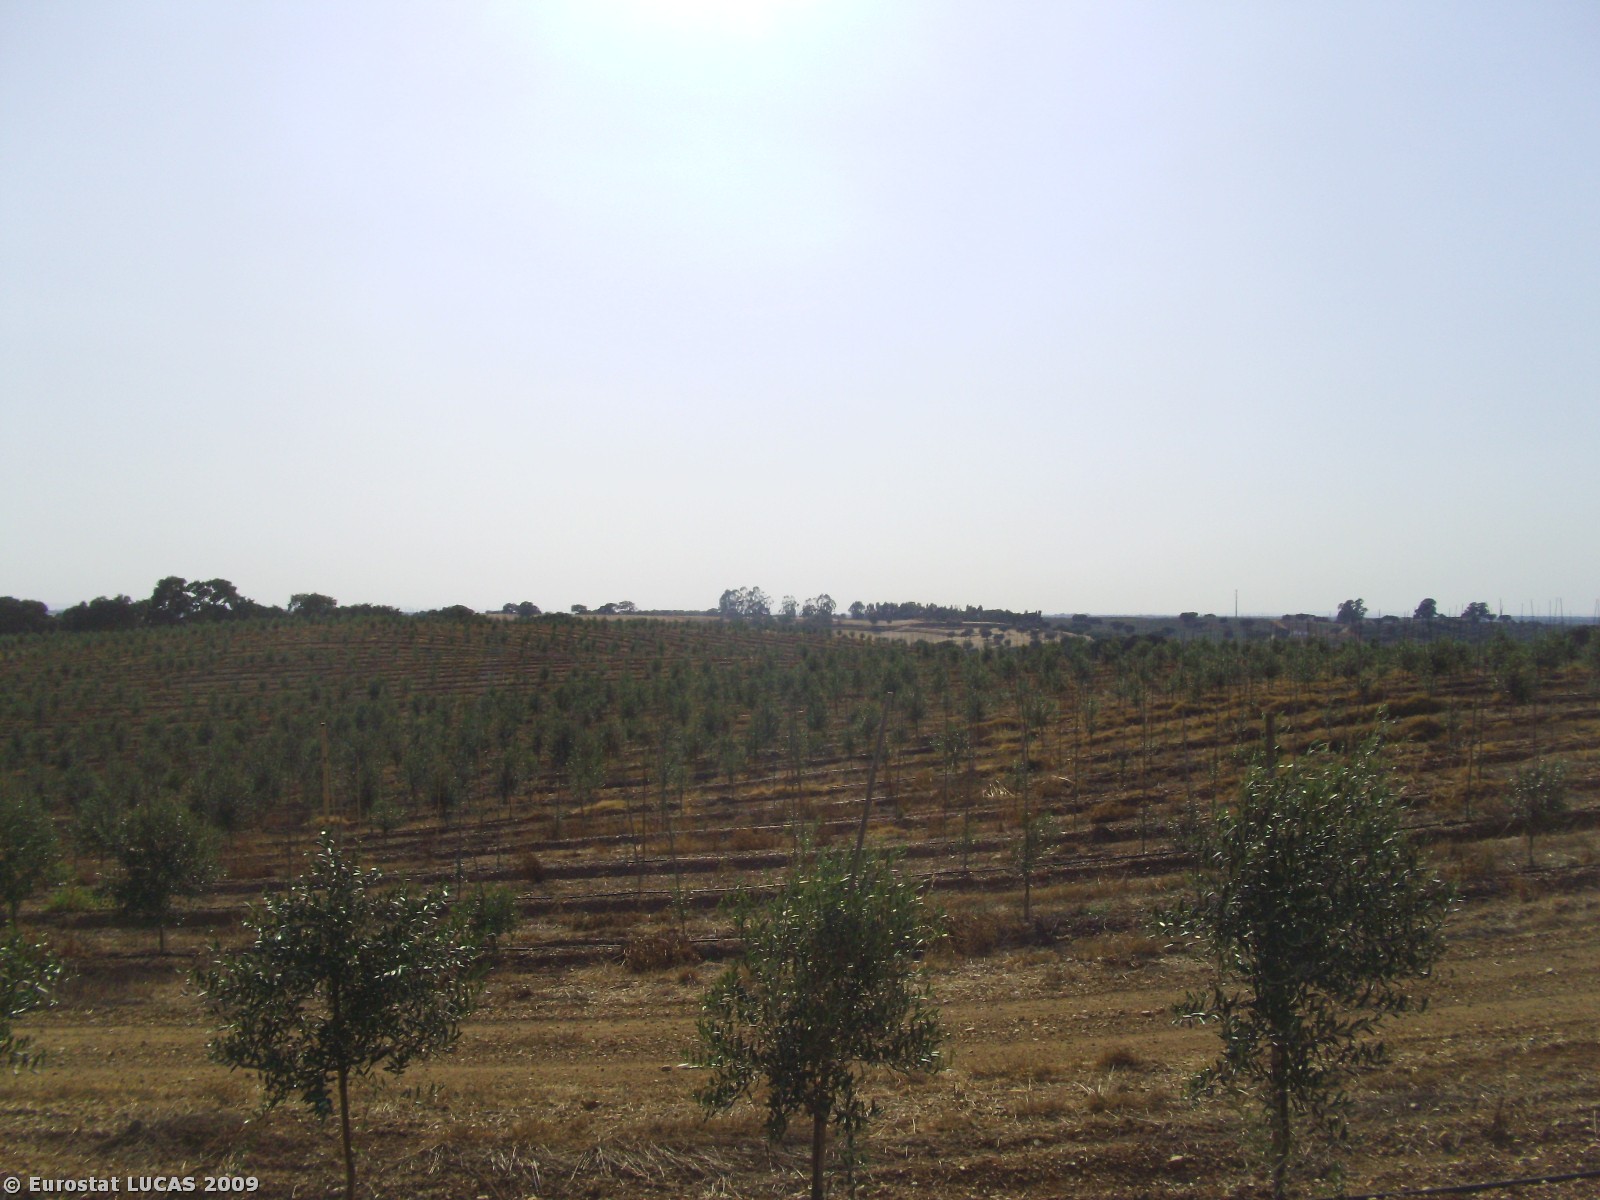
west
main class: Cropland
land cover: Olive groves
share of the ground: 50 - 75 %
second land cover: Spontaneously vegetated surfaces
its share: > 75 %
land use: Agriculture (excluding fallow land and kitchen gardens)
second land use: Fallow land
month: August
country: PT
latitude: 37.8762
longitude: -8.3286
